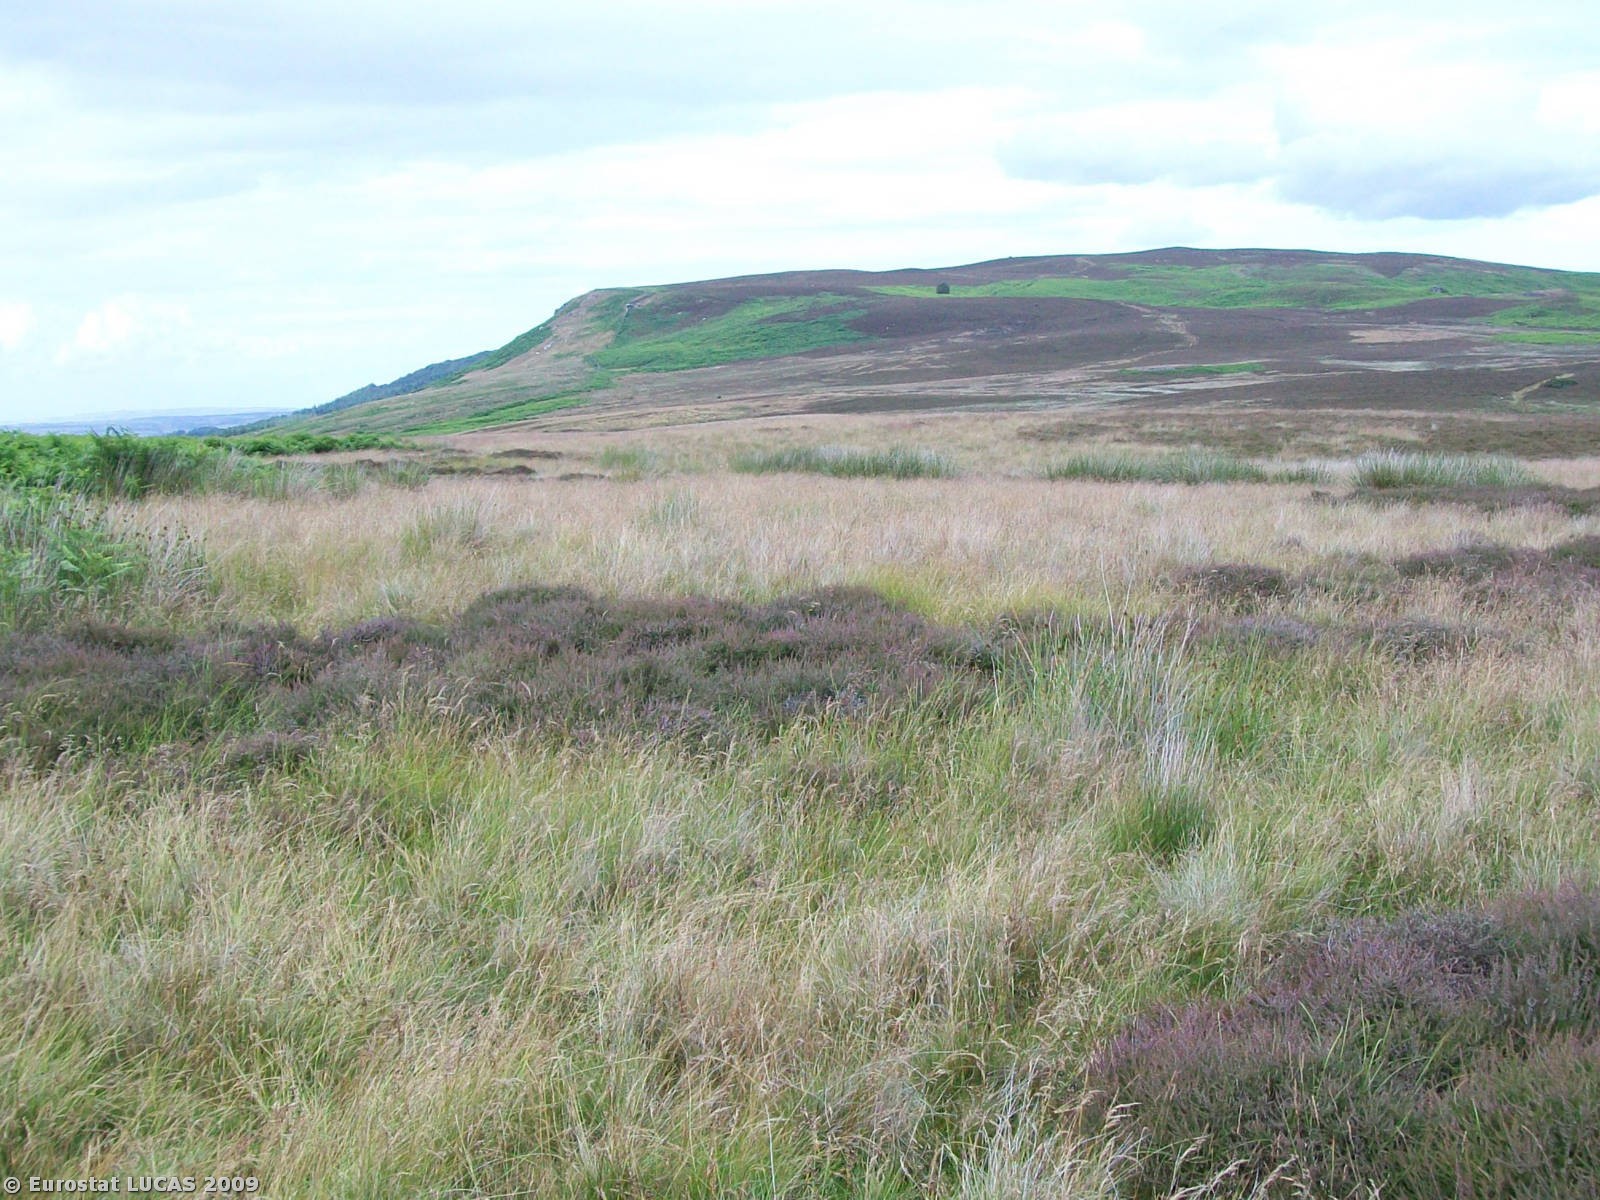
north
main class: Shrubland
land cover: Shrubland without tree cover
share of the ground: > 75 %
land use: Agriculture (excluding fallow land and kitchen gardens)
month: July
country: GB
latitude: 55.4886
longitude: -1.8733
